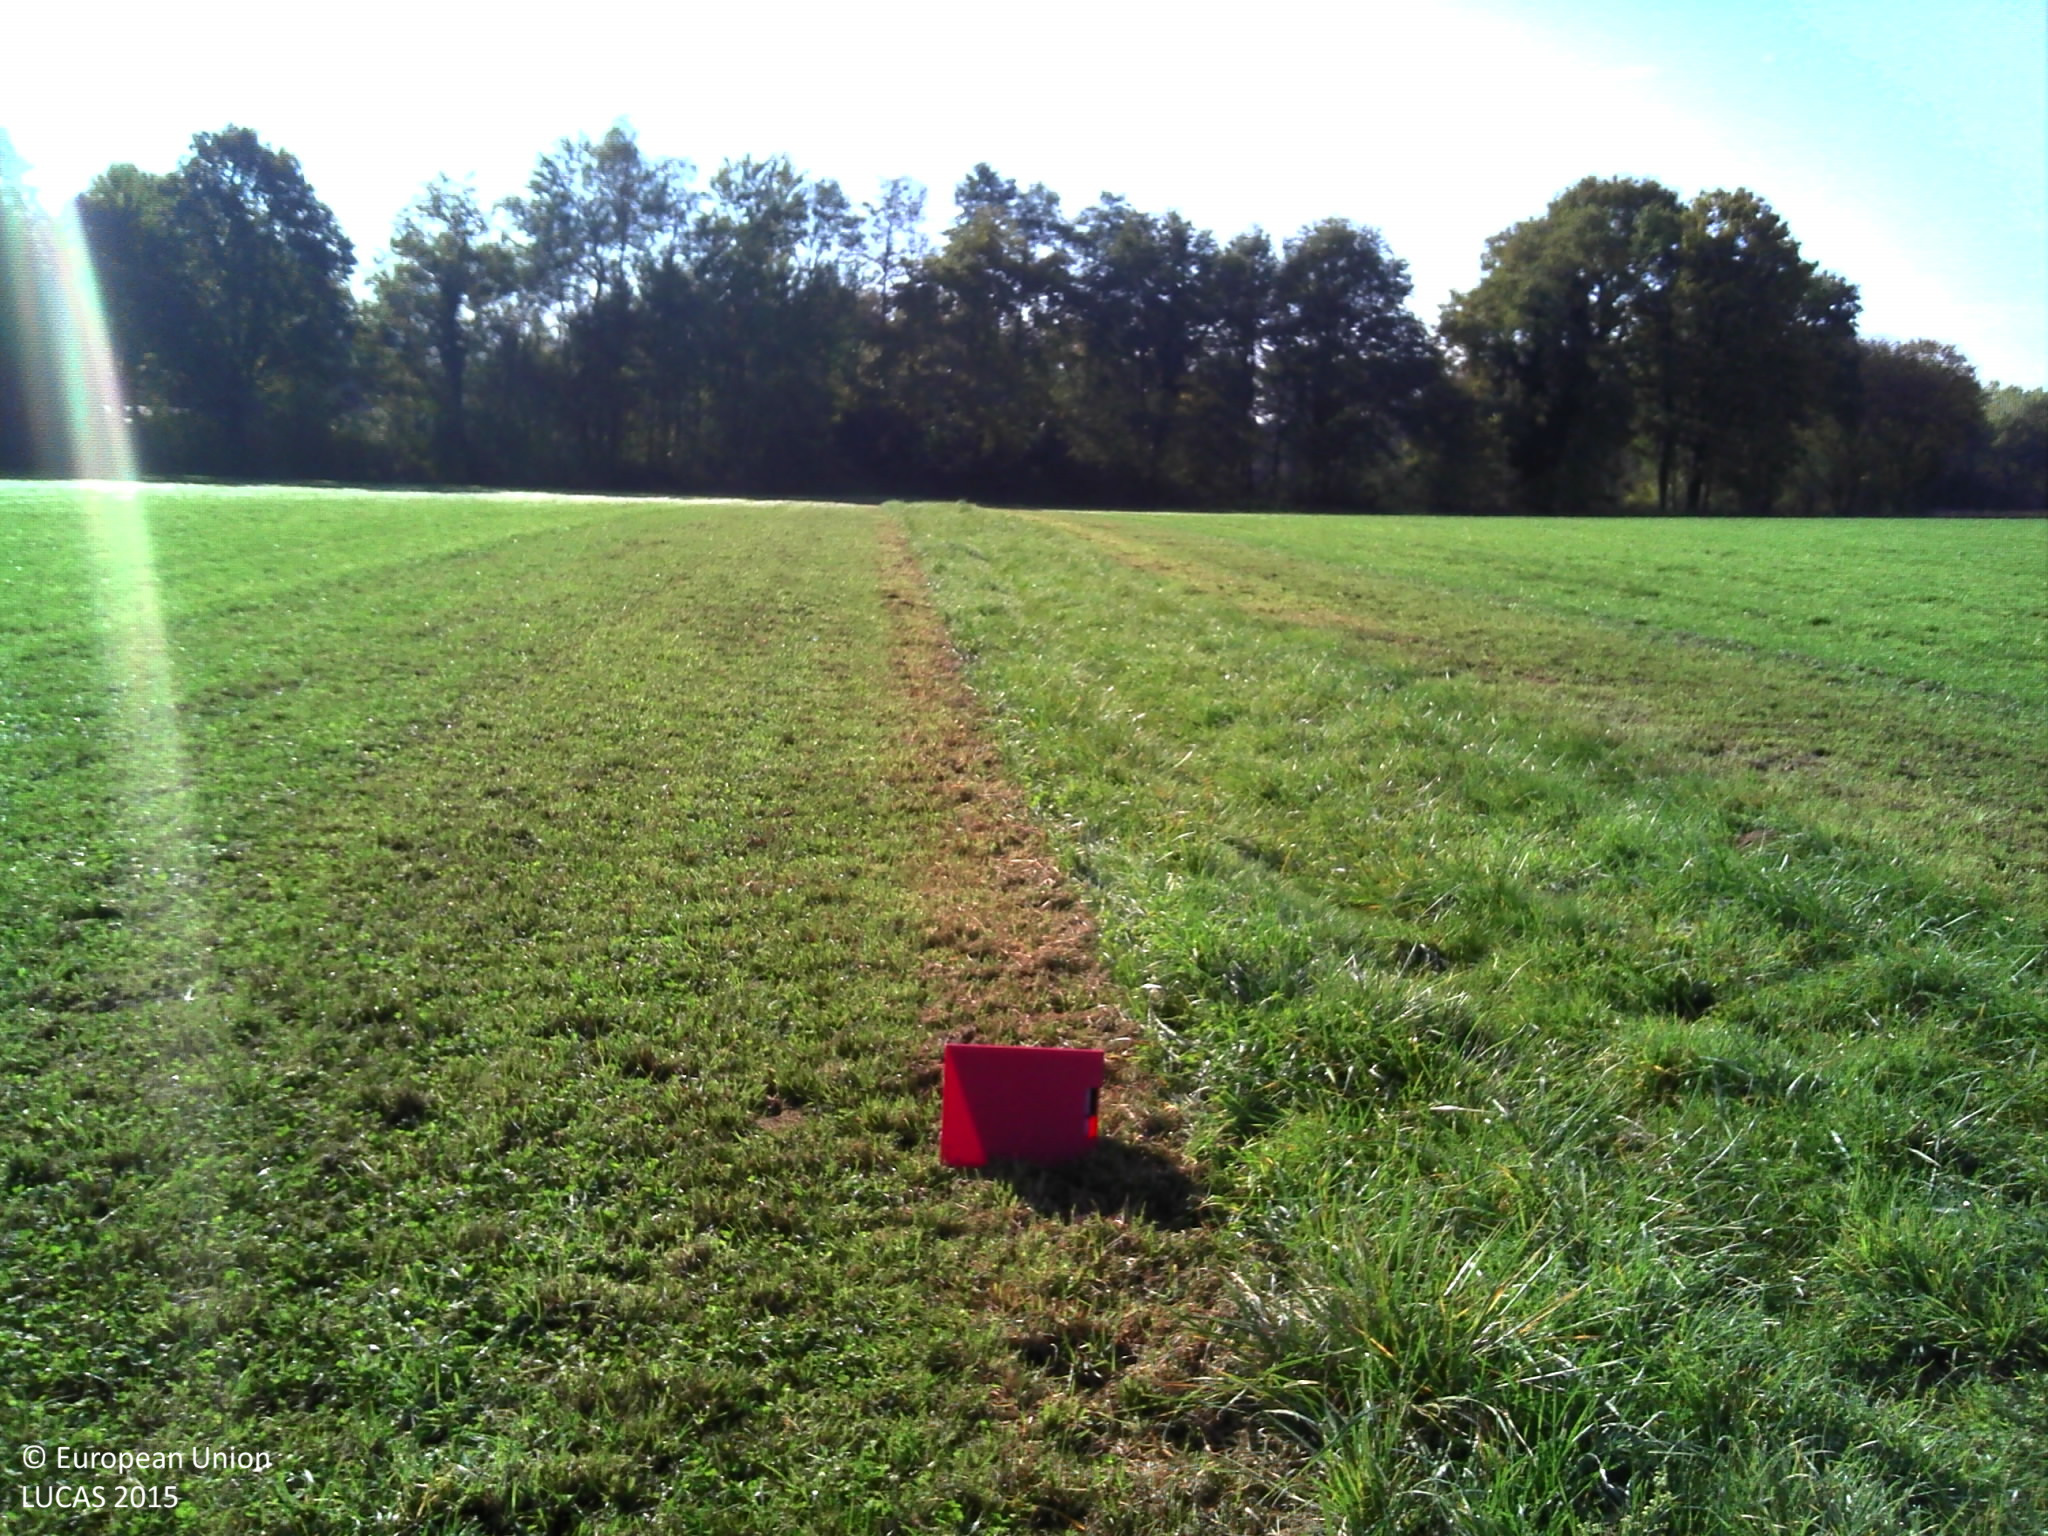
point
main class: Cropland
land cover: Temporary grasslands
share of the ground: > 75 %
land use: Agriculture (excluding fallow land and kitchen gardens)
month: October
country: FR
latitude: 46.0668
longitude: 5.2846
